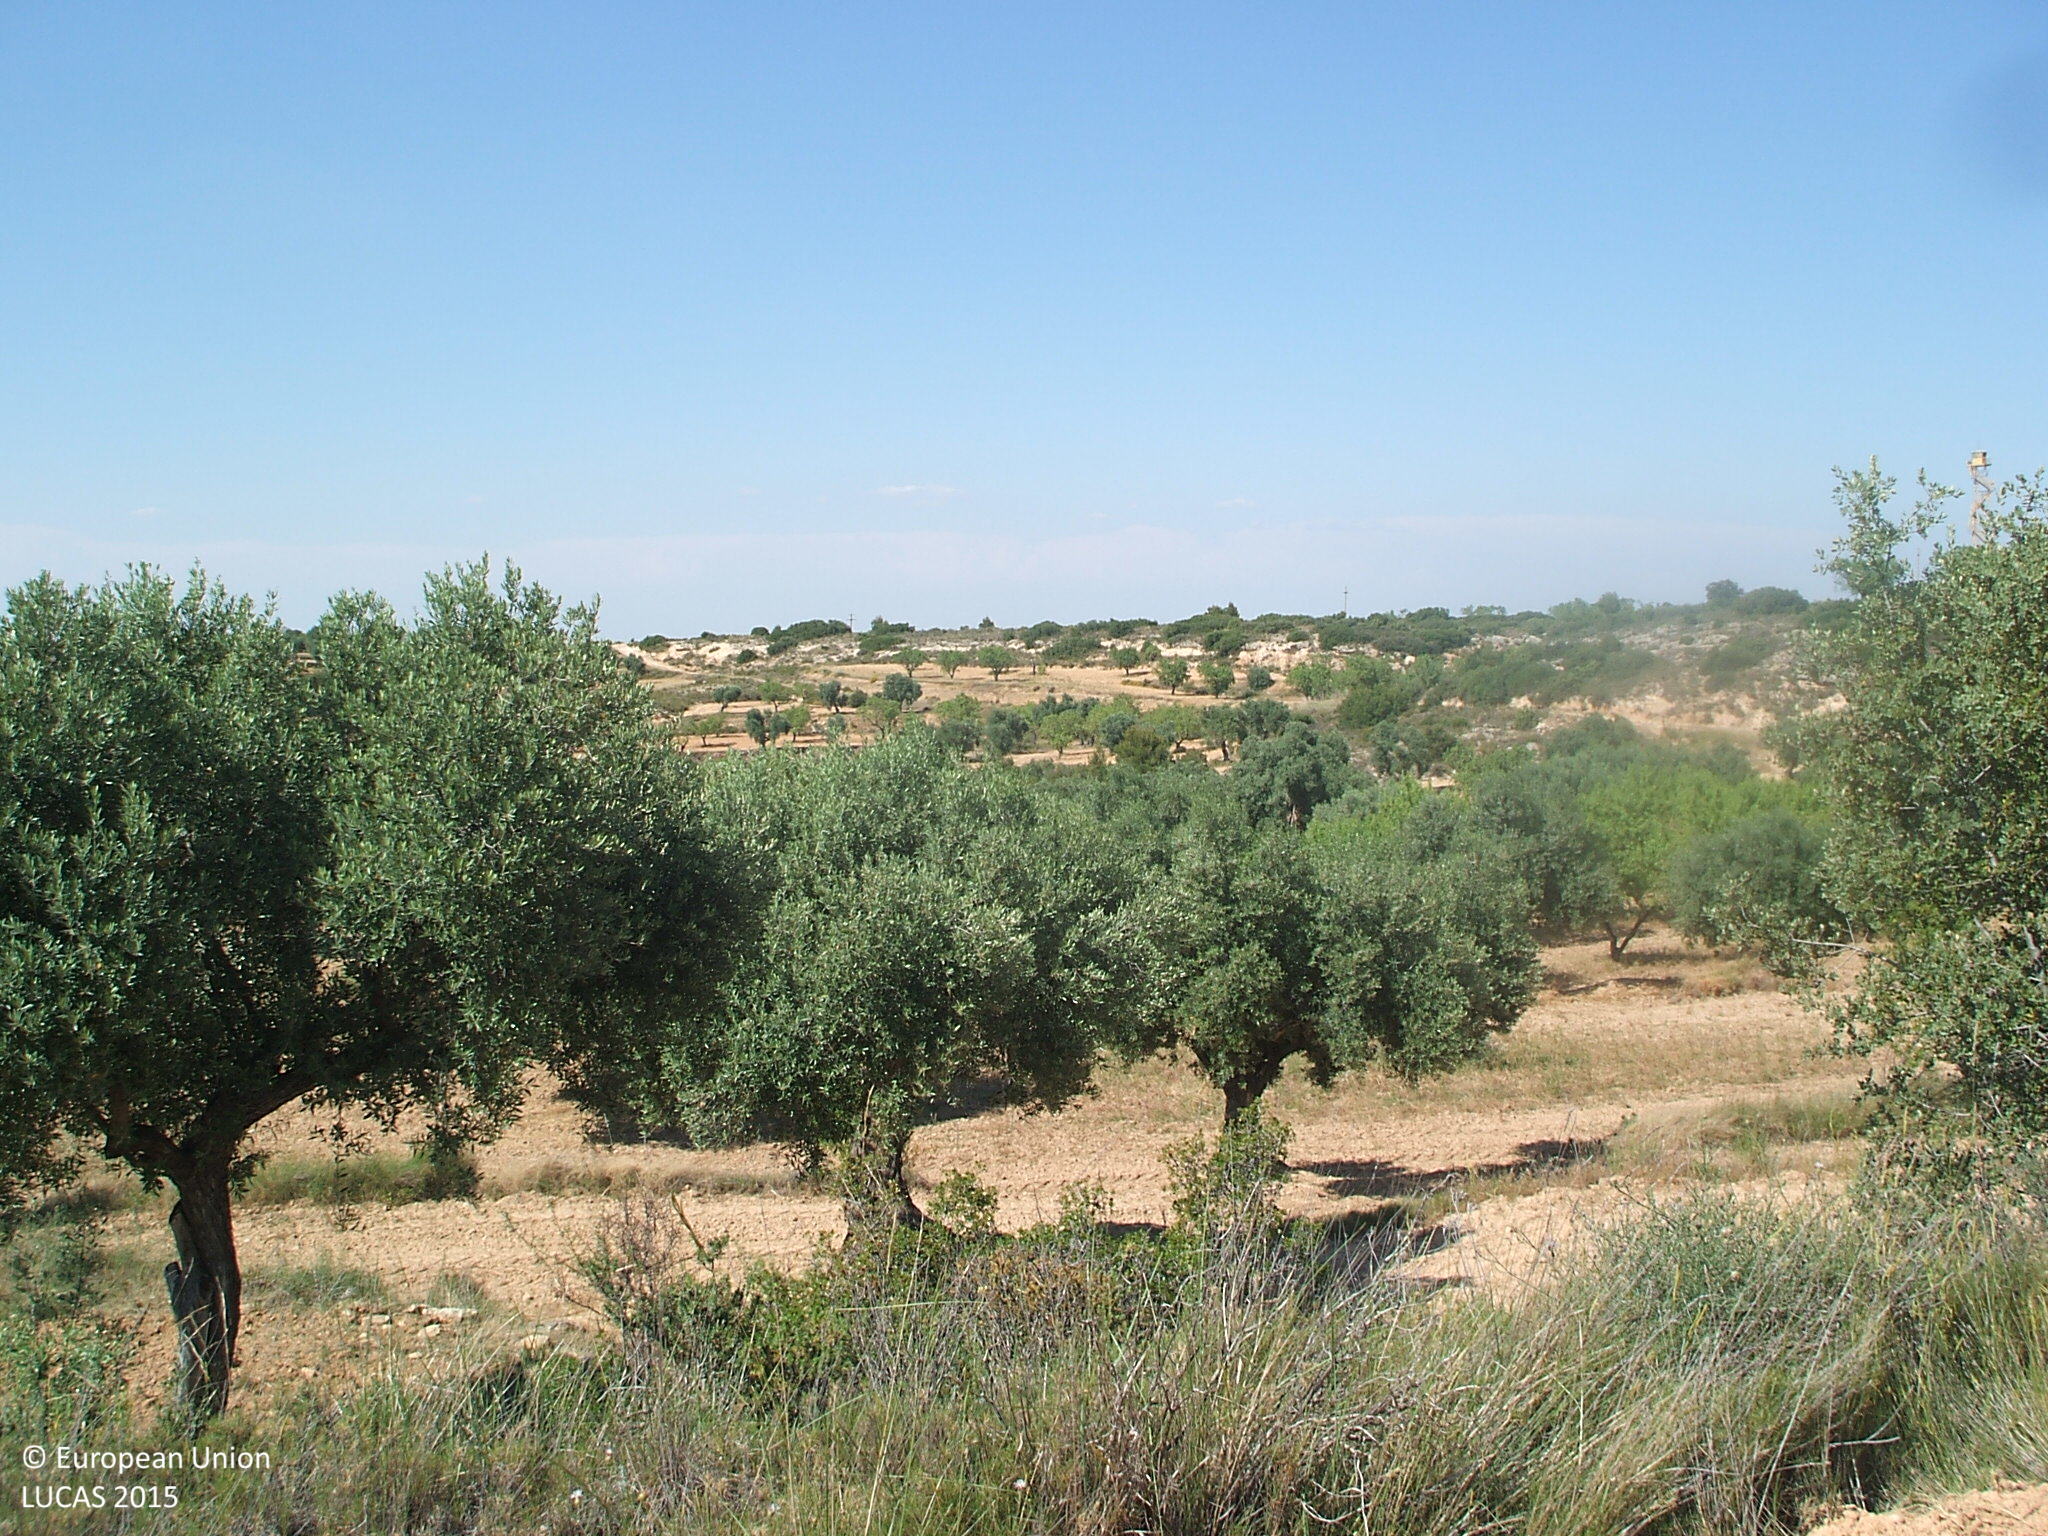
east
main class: Cropland
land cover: Olive groves
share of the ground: 10 - 25 %
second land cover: Other bare soil
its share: > 75 %
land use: Agriculture (excluding fallow land and kitchen gardens)
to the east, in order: Olive groves; Other bare soil; Grass margins; Olive groves; Grass margins; Olive groves; Shrubland without tree cover; Shrubland with sparse tree cover; Rocks and stones; Grass margins; Nuts trees
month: June
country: ES
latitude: 40.9725
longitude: -0.0280
